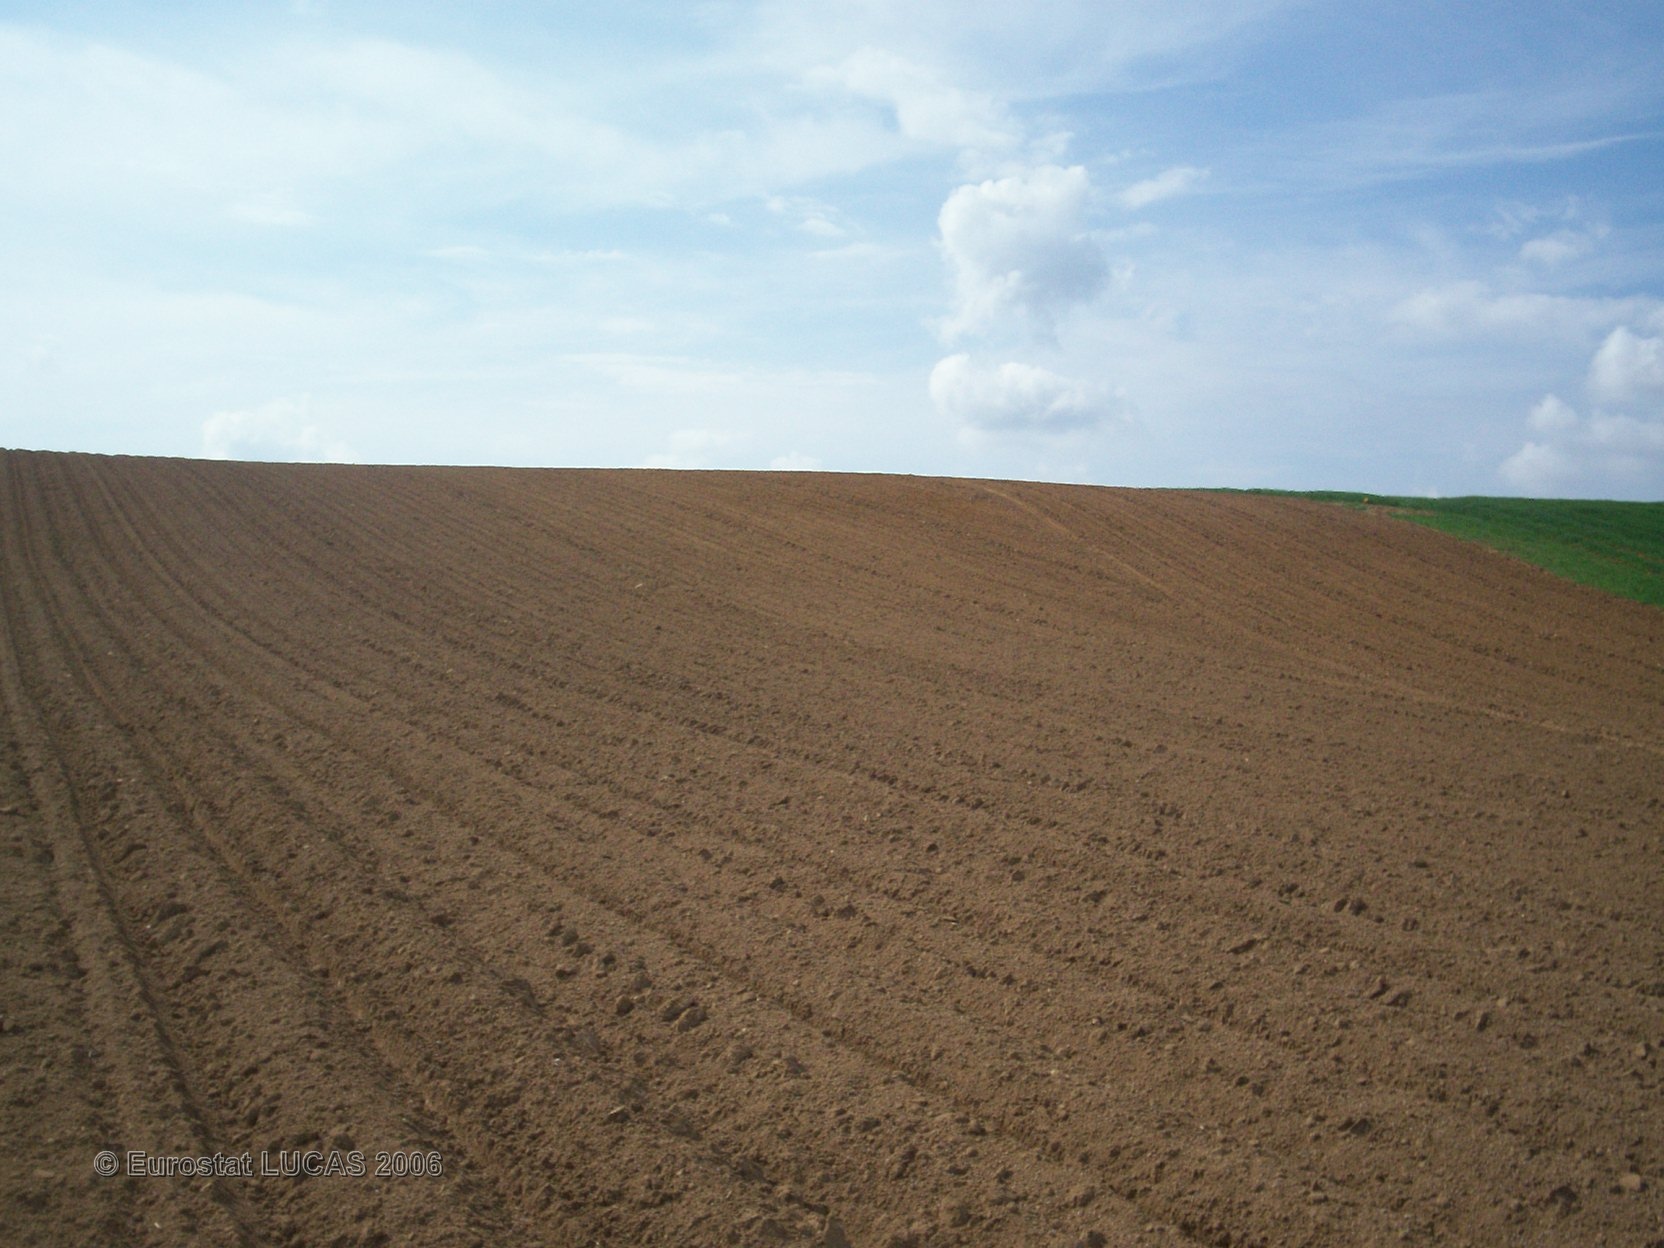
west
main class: Cropland
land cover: Potatoes
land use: Agriculture (excluding fallow land and kitchen gardens)
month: April
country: FR
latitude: 49.9429
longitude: 2.5889
